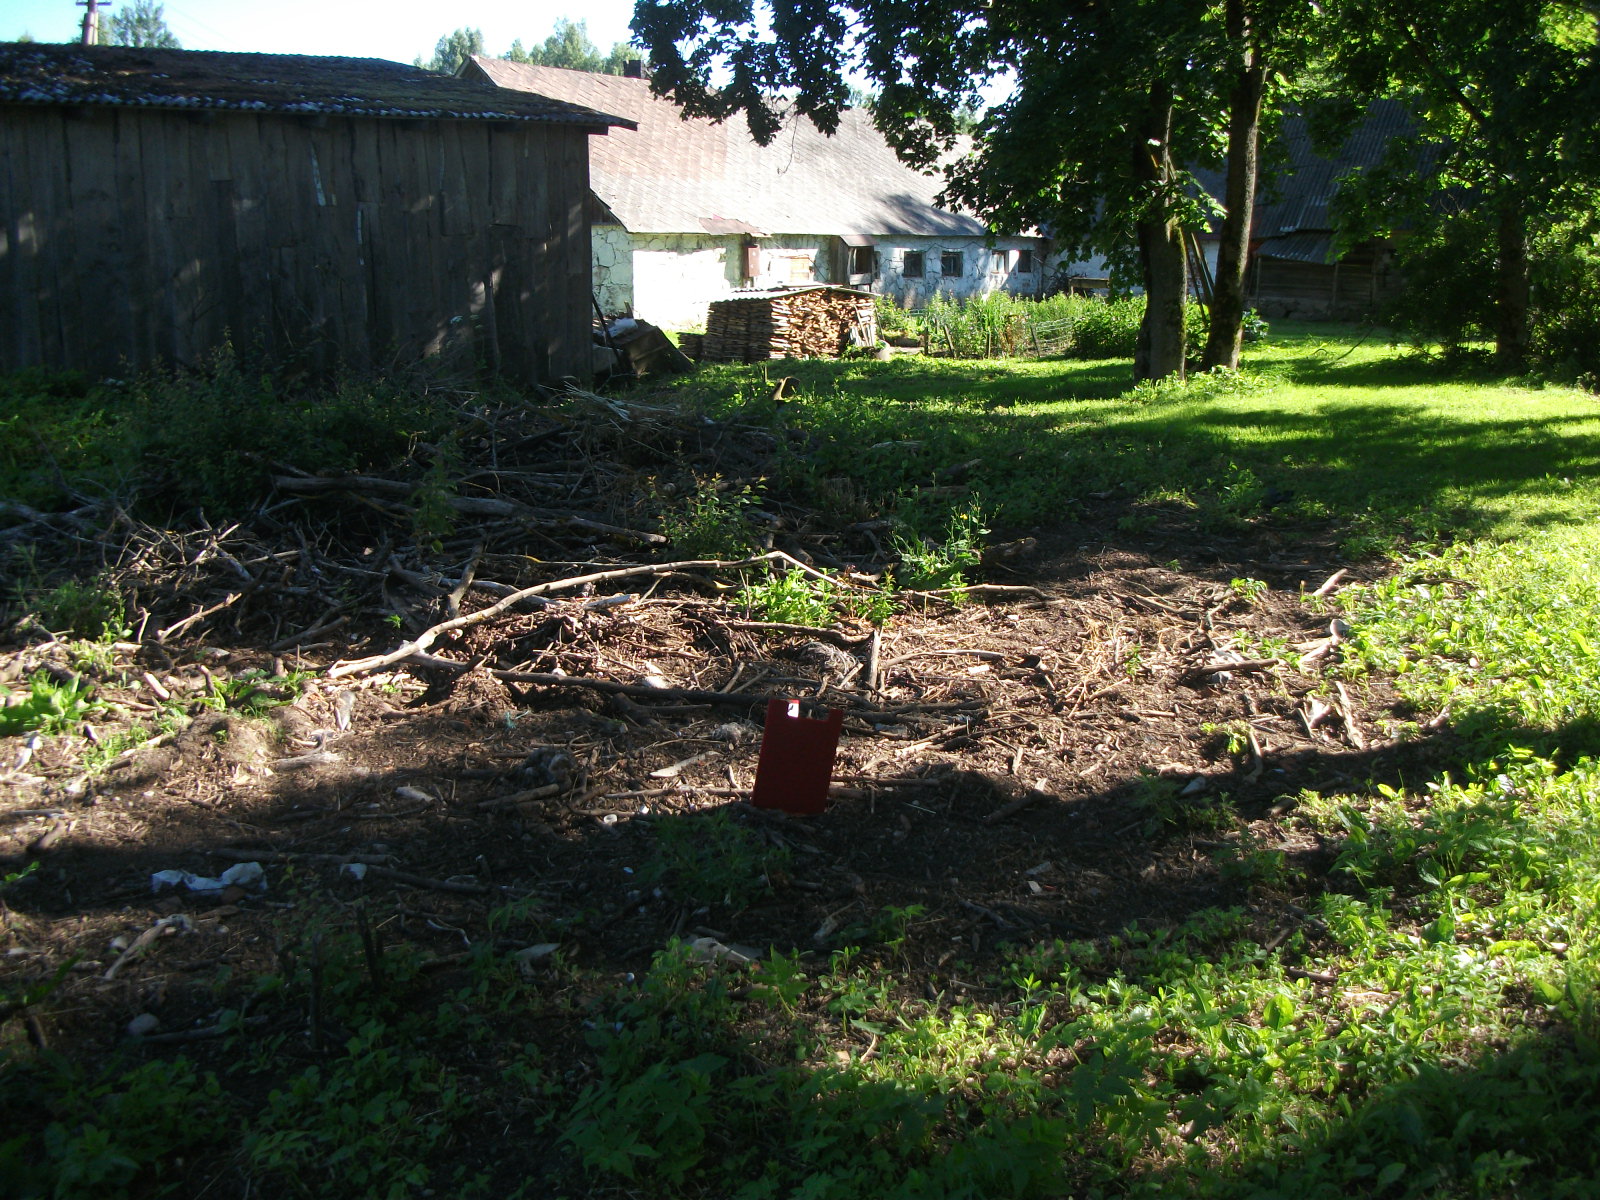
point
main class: Woodland
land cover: Broadleaved woodland
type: non-riverine alder, birch or aspen forest
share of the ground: > 75 %
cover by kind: broadleaved forest trees 85 %, unconsolidated bare surface 15 %
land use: Residential
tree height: > 5 m
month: July
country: LV
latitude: 56.7062
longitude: 26.0936
